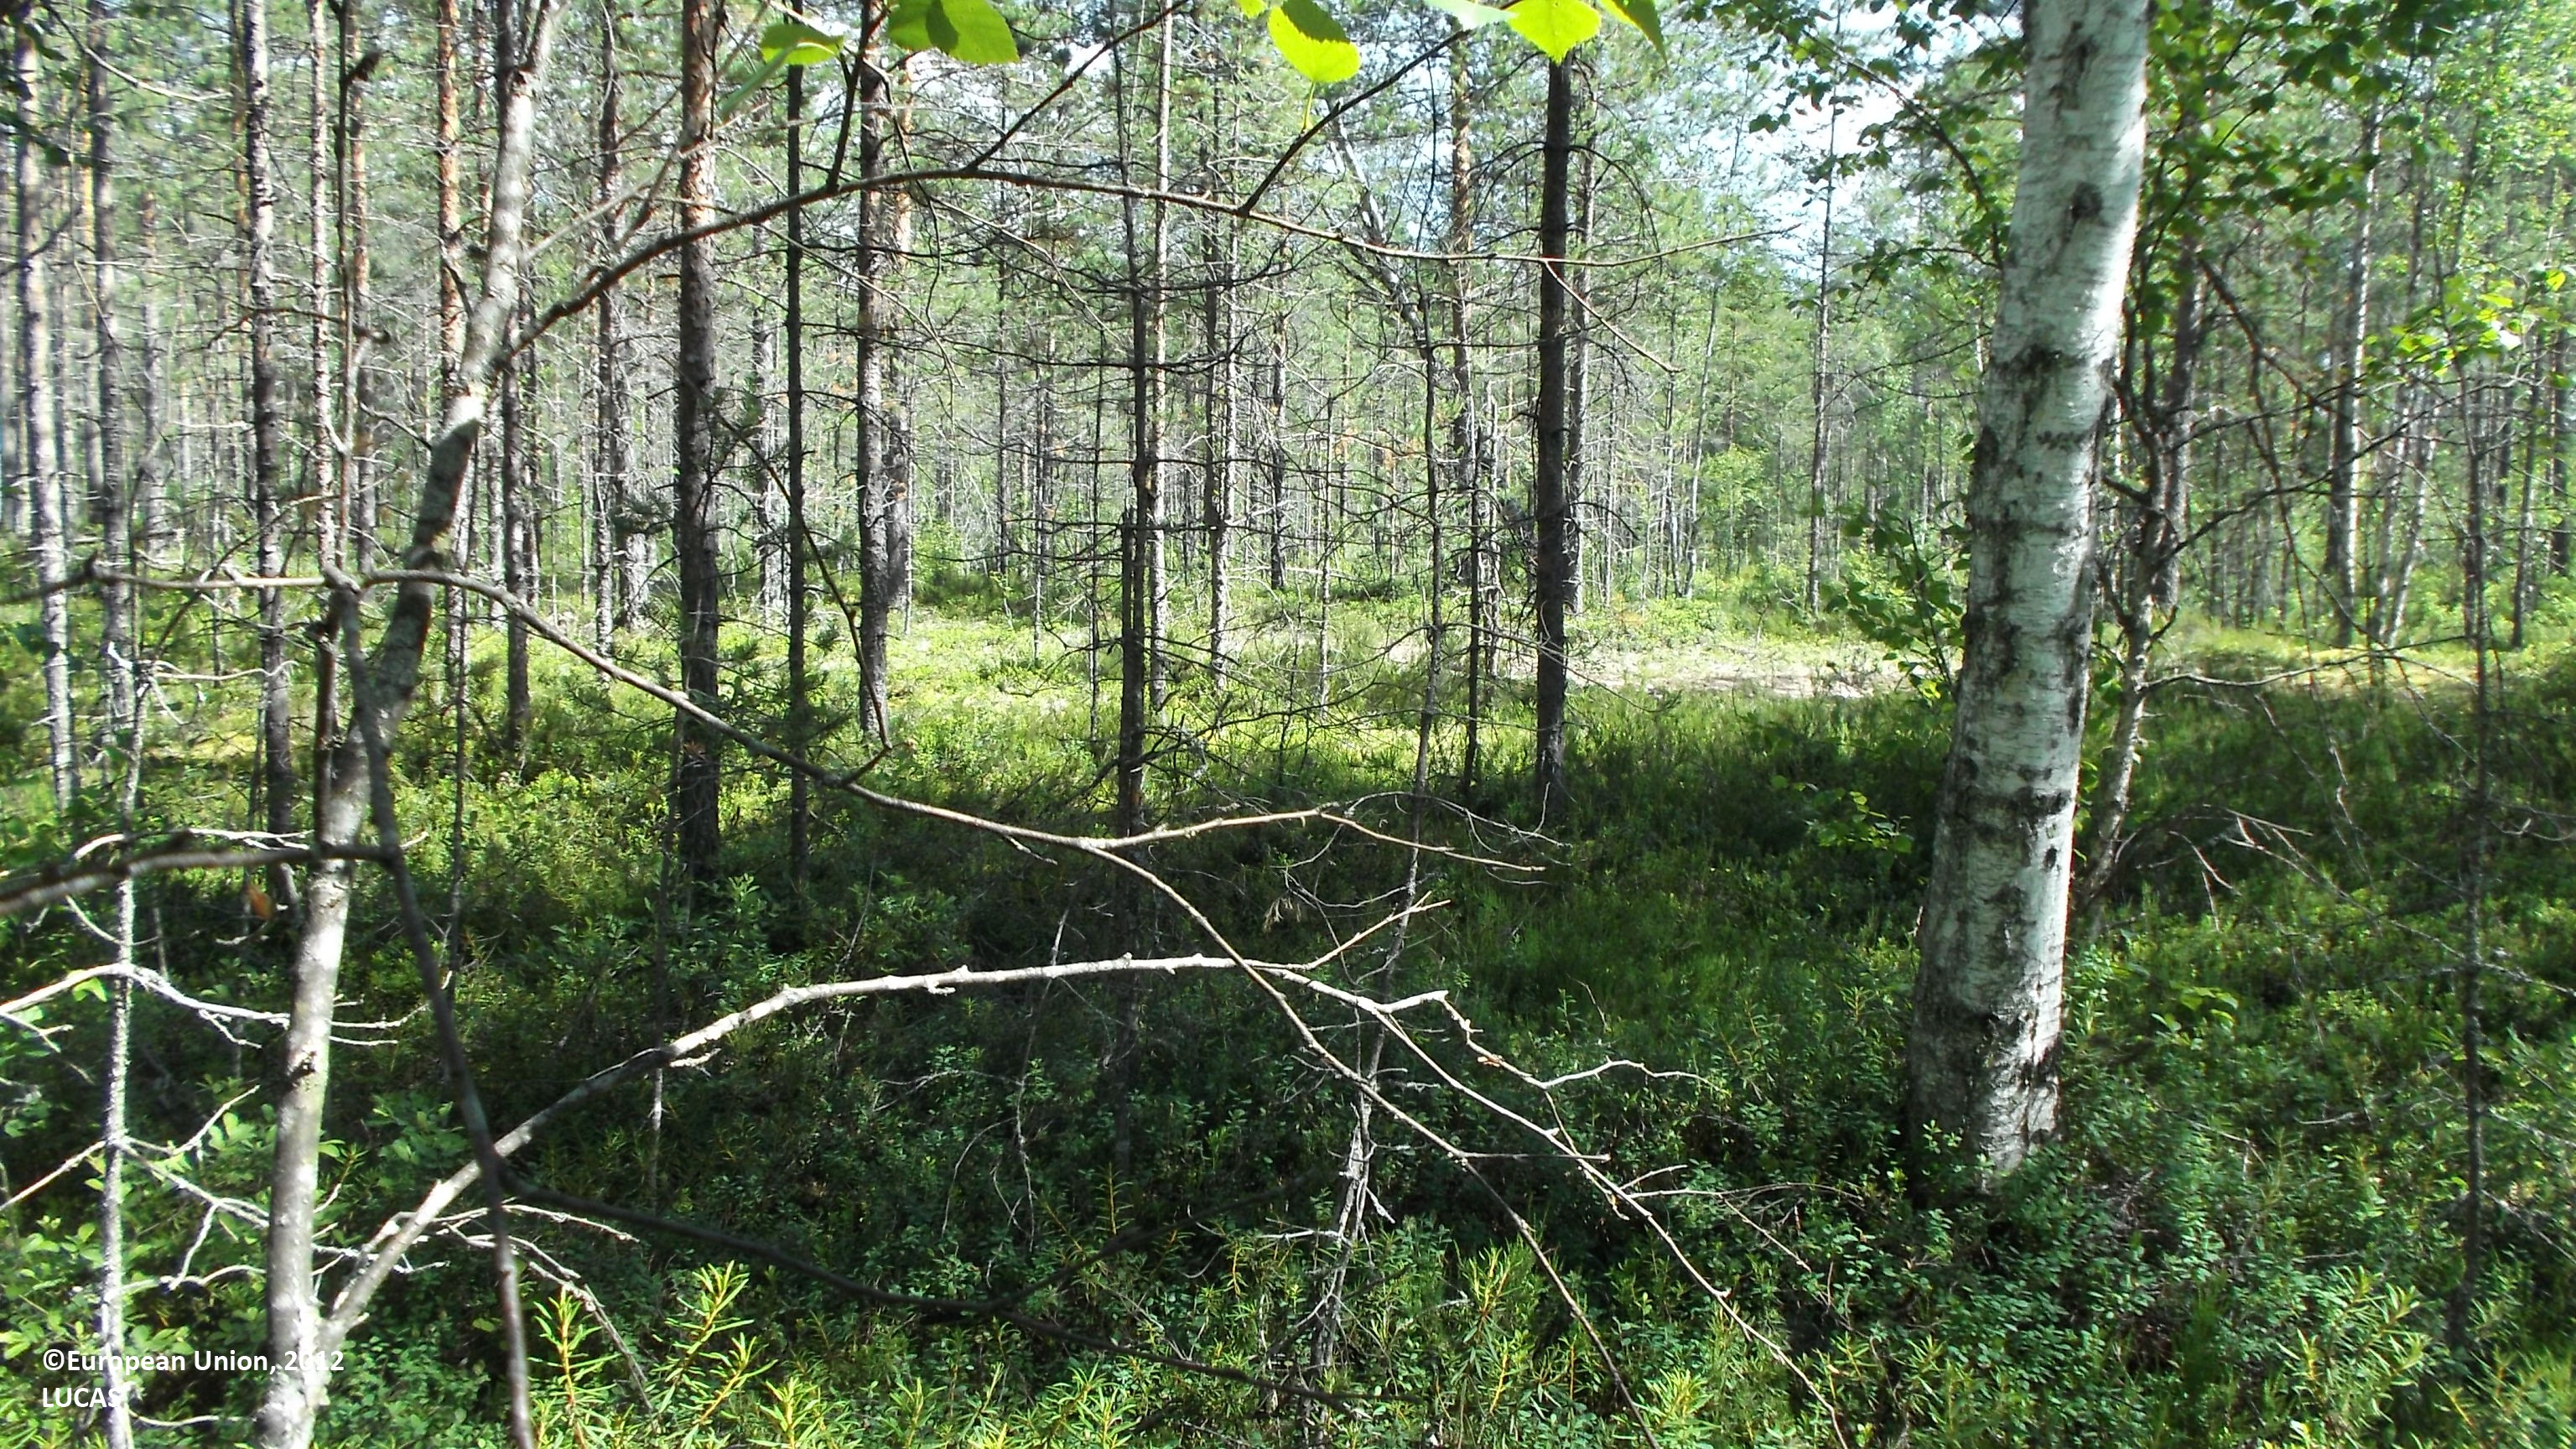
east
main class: Woodland
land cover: Pine dominated mixed woodland
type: boreal forest
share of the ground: 25 - 50 %
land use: Forestry
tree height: > 5 m
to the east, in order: Pine dominated mixed woodland; Other mixed woodland; Pine dominated mixed woodland; Ditches and canals; Pine dominated mixed woodland; Pine dominated coniferous woodland; Spontaneously vegetated surfaces; Ditches and canals; Shrubland with sparse tree cover; Pine dominated mixed woodland
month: July
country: FI
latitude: 63.6149
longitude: 23.9240
